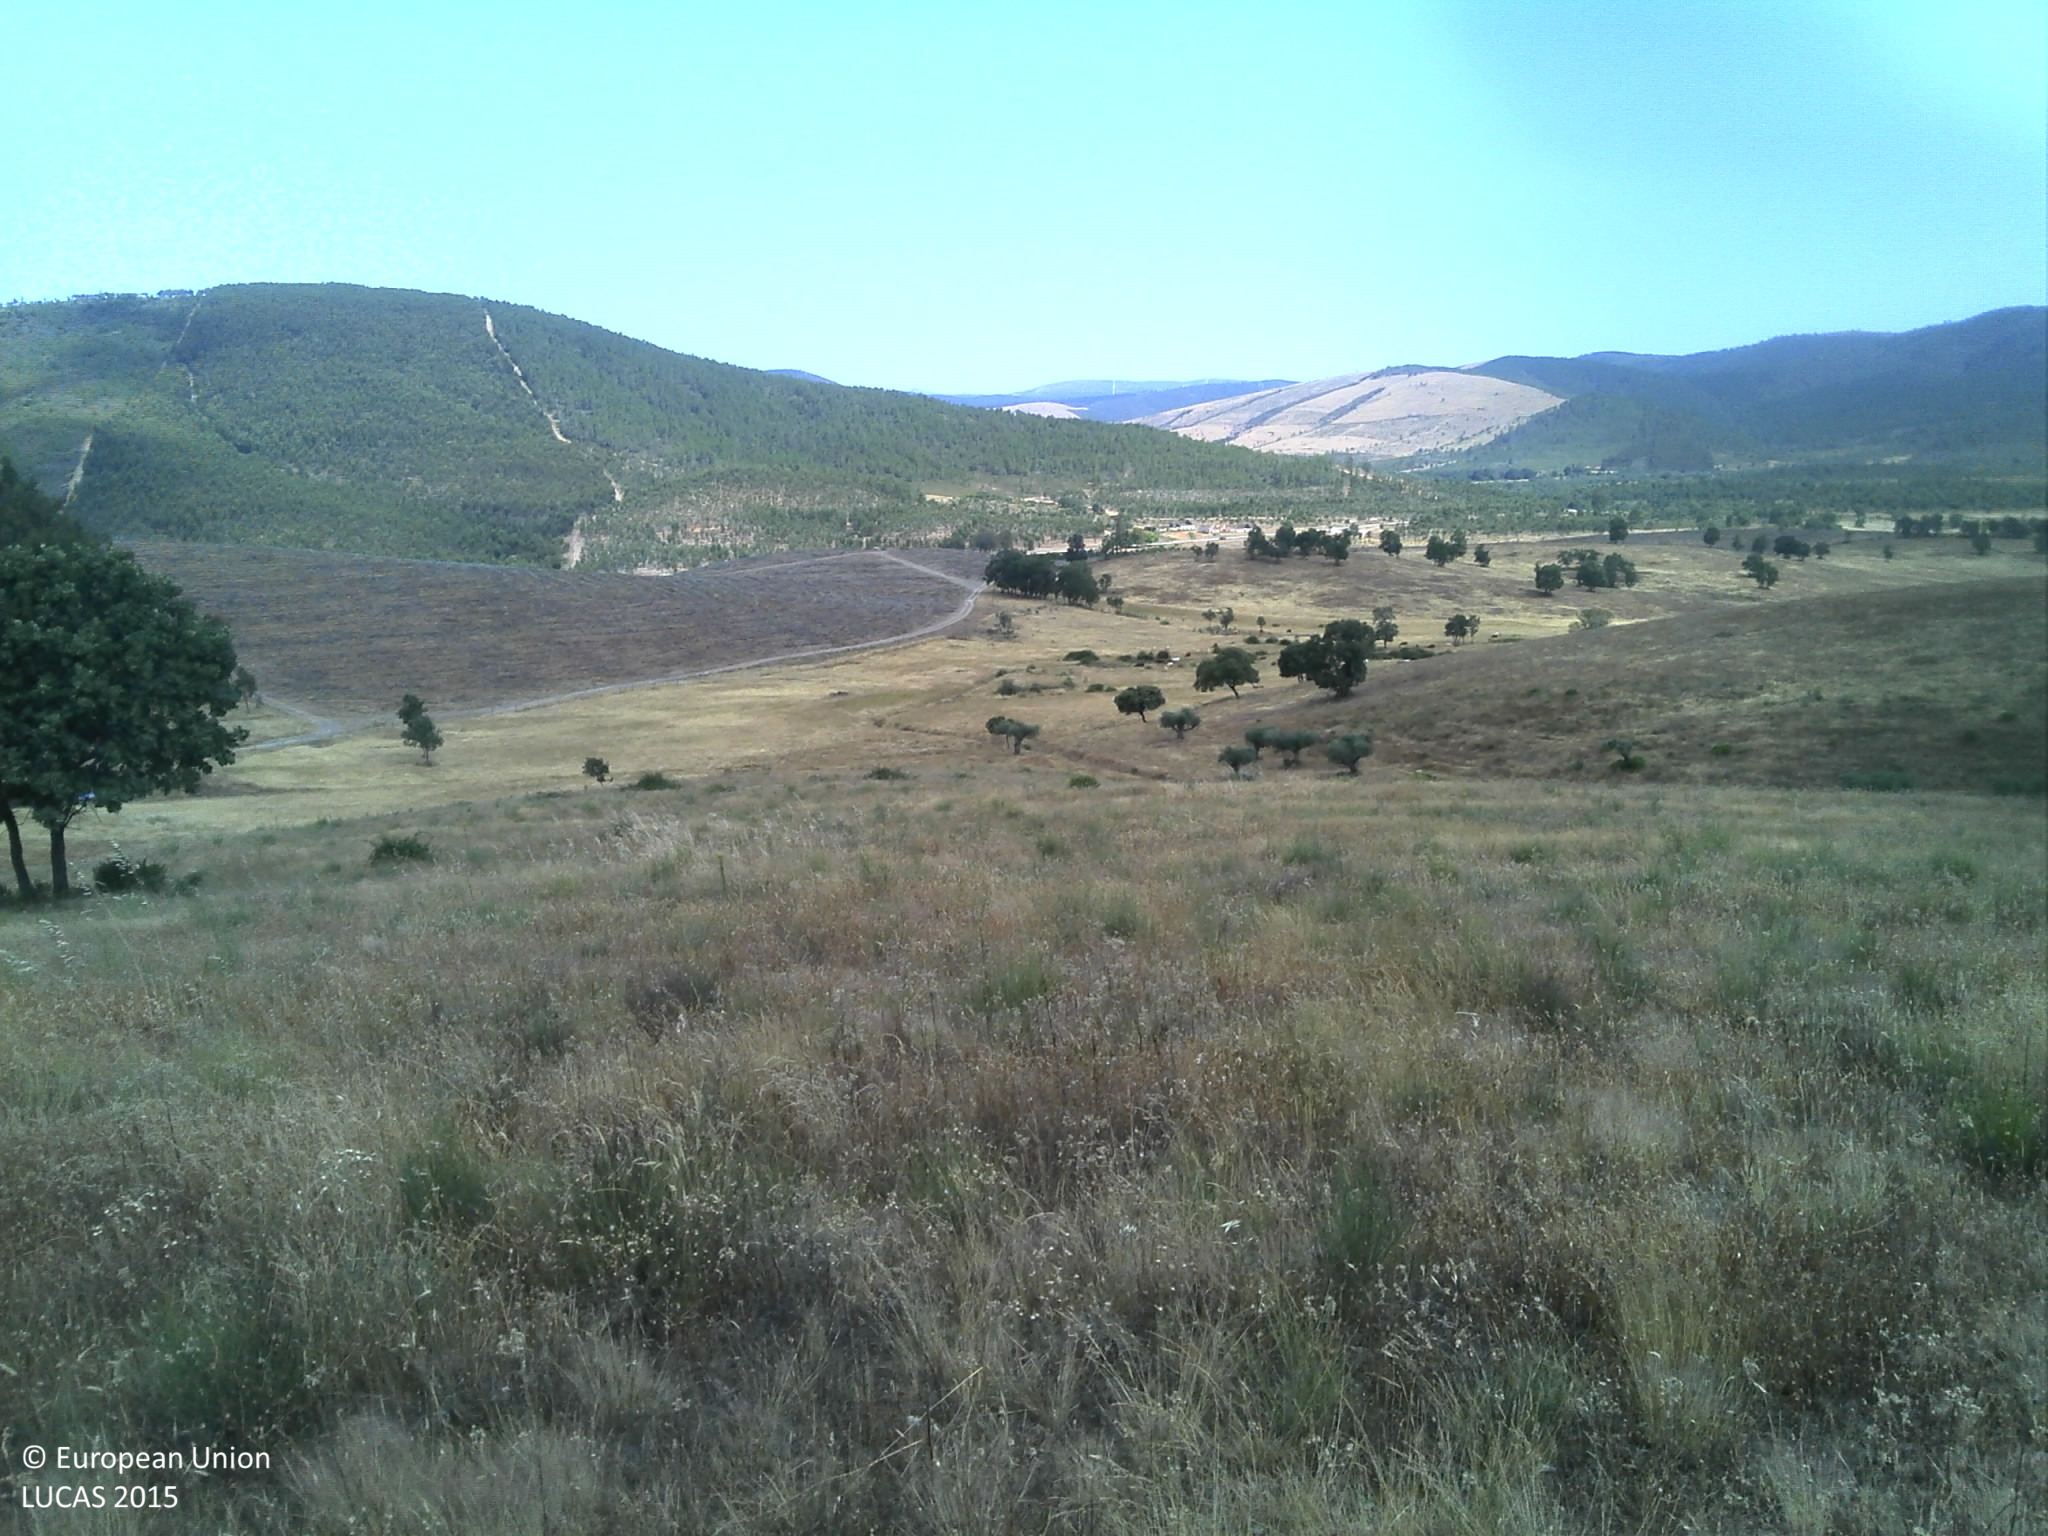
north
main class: Grassland
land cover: Grassland with sparse tree/shrub cover
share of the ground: 50 - 75 %
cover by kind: herbaceous plants 65 %, unconsolidated bare surface 25 %, broadleaved forest trees 5 %
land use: Agriculture (excluding fallow land and kitchen gardens)
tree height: > 5 m
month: June
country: PT
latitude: 40.1850
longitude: -7.1389
